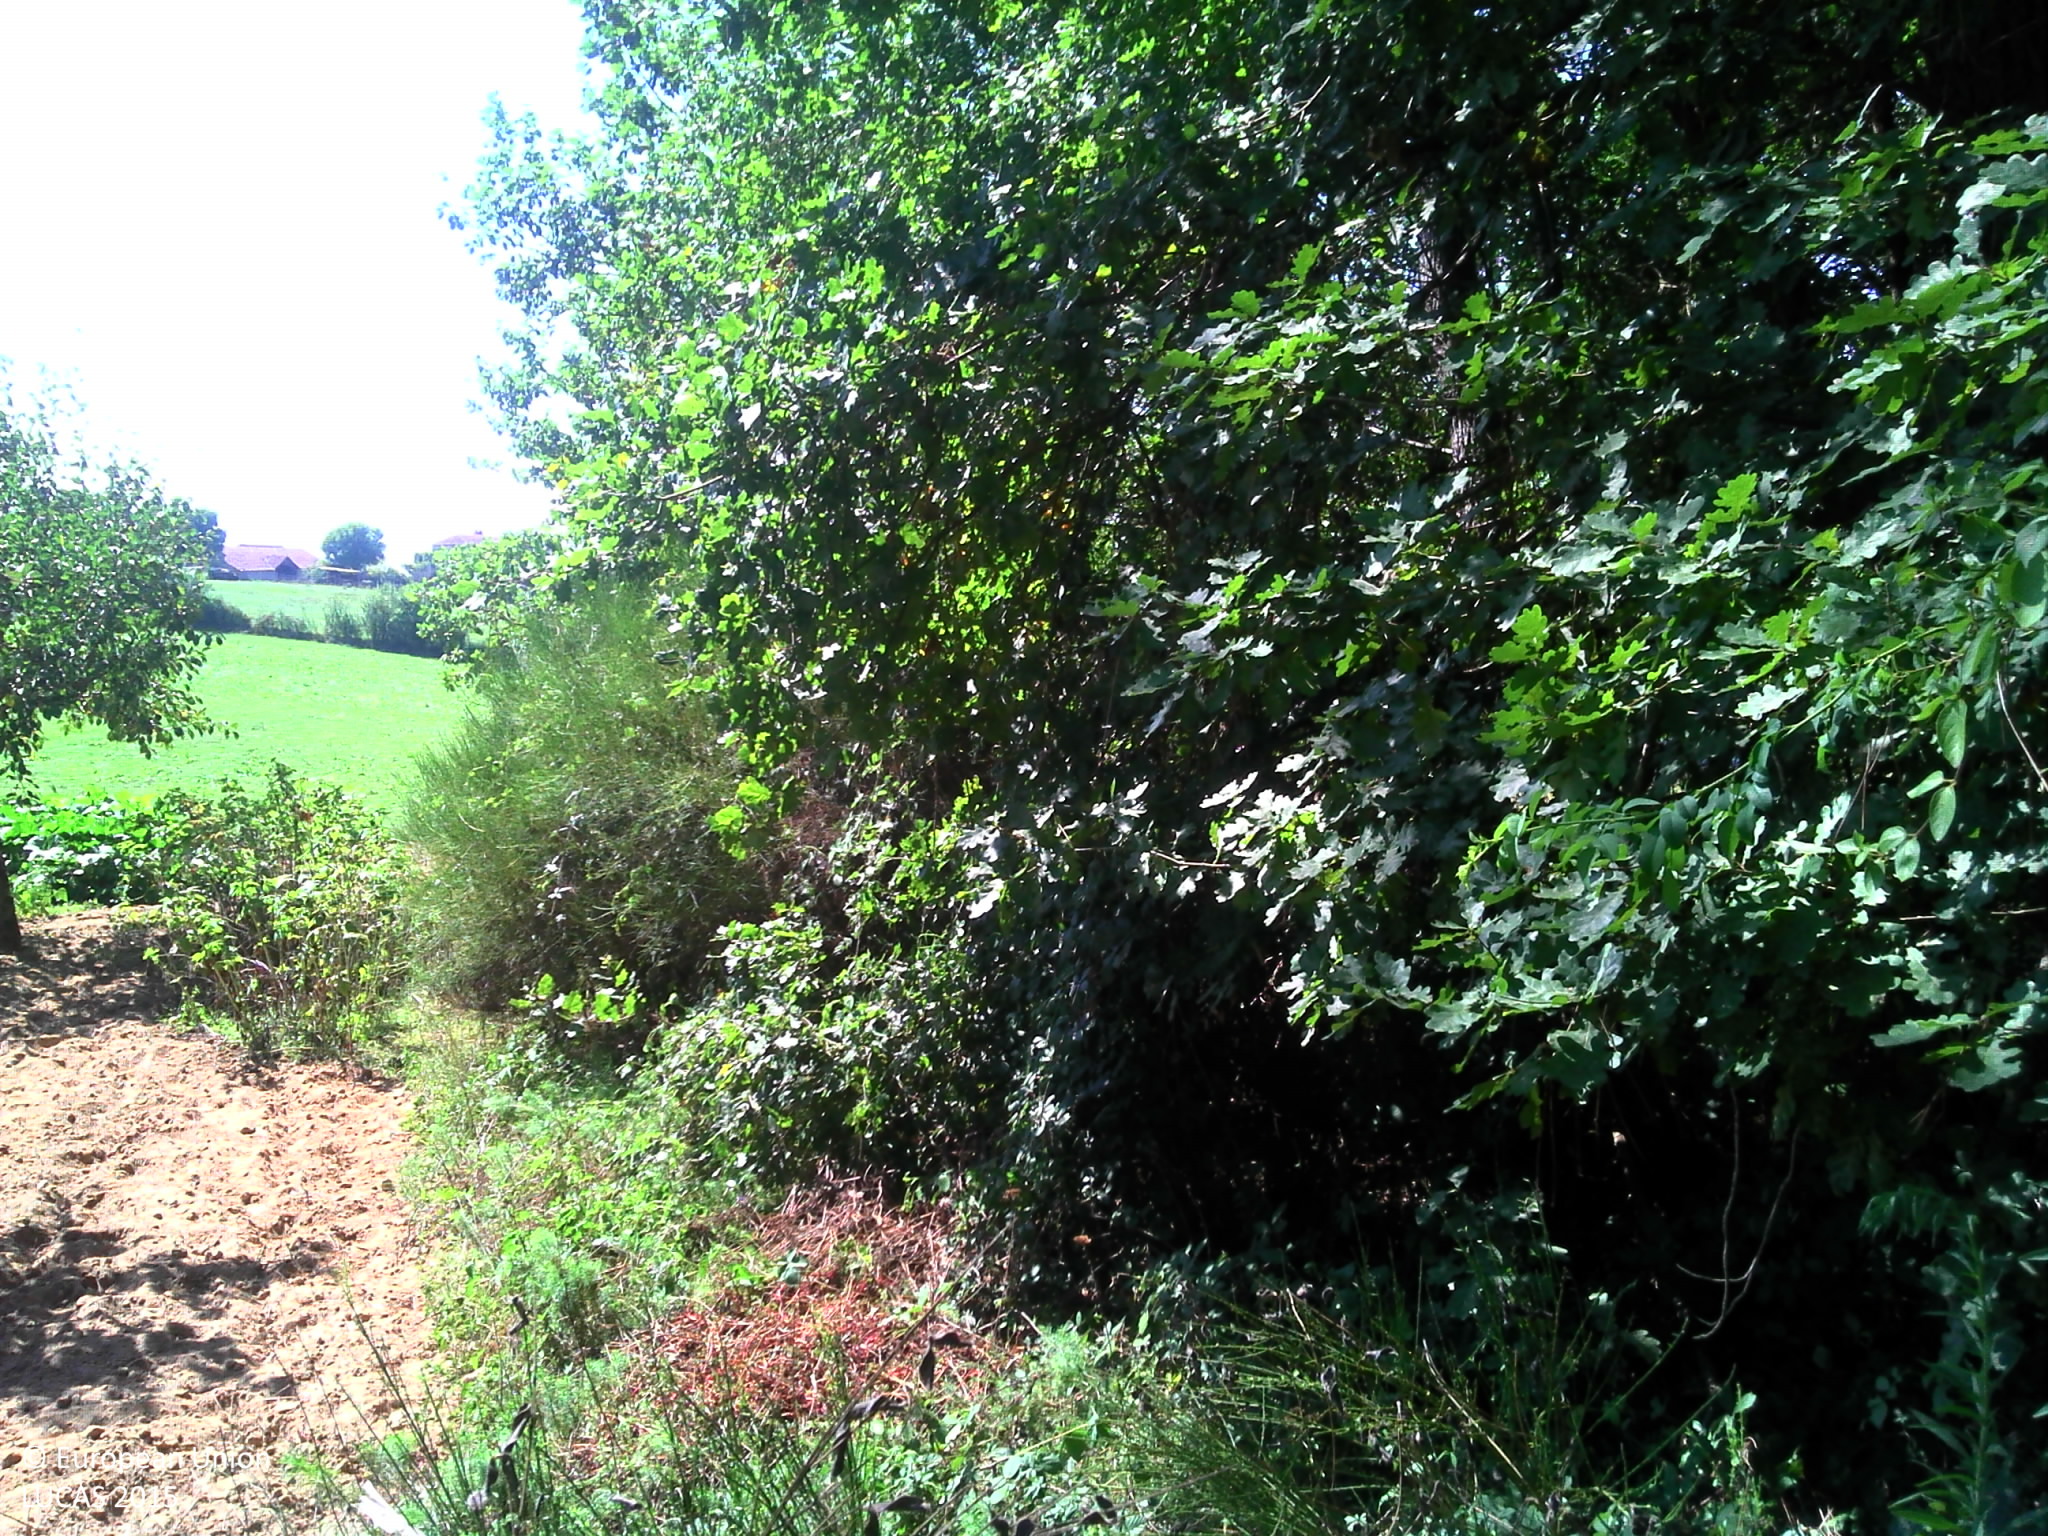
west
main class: Woodland
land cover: Pine dominated mixed woodland
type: coniferous forest of the mediterranean region
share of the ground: > 75 %
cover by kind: broadleaved forest trees 60 %, coniferous forest trees 30 %, shrubs 10 %
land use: Forestry
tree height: > 5 m
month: August
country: FR
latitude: 44.6076
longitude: 1.1631
